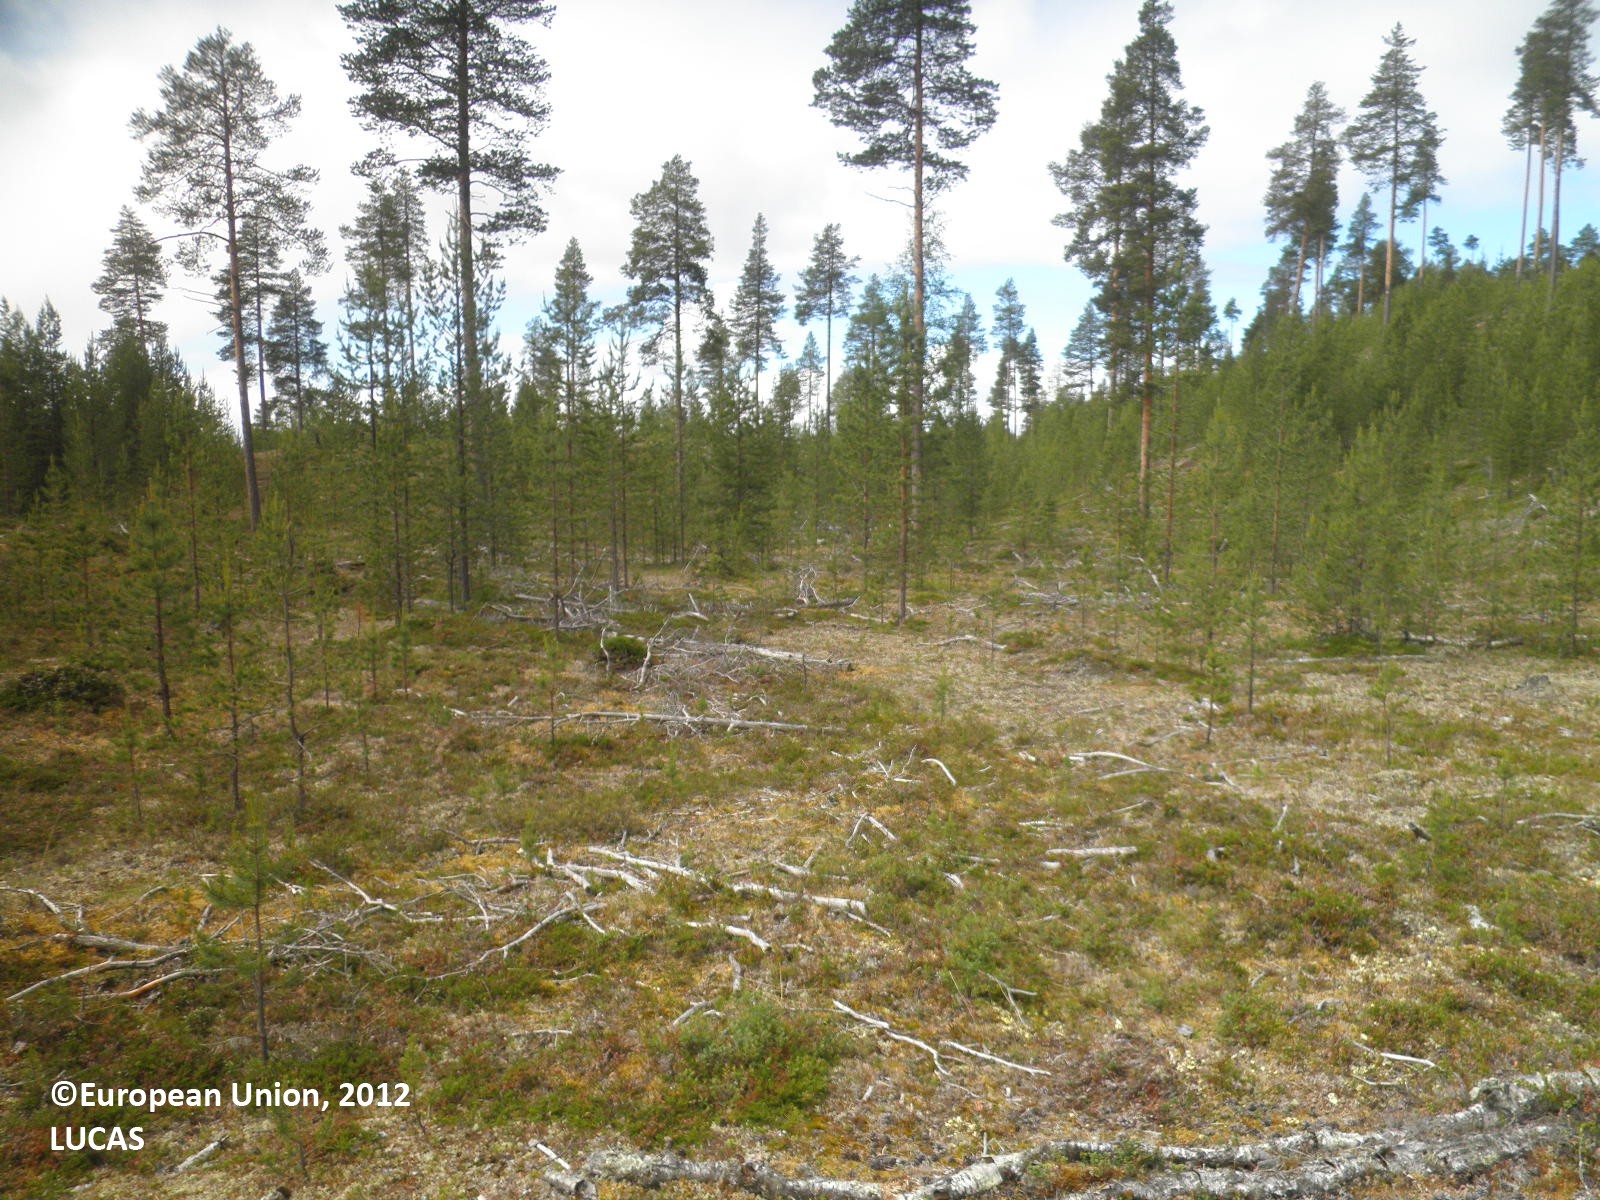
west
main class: Woodland
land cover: Pine dominated coniferous woodland
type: boreal forest
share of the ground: 25 - 50 %
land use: Forestry
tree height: > 5 m
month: July
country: FI
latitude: 68.6977
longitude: 27.8706
